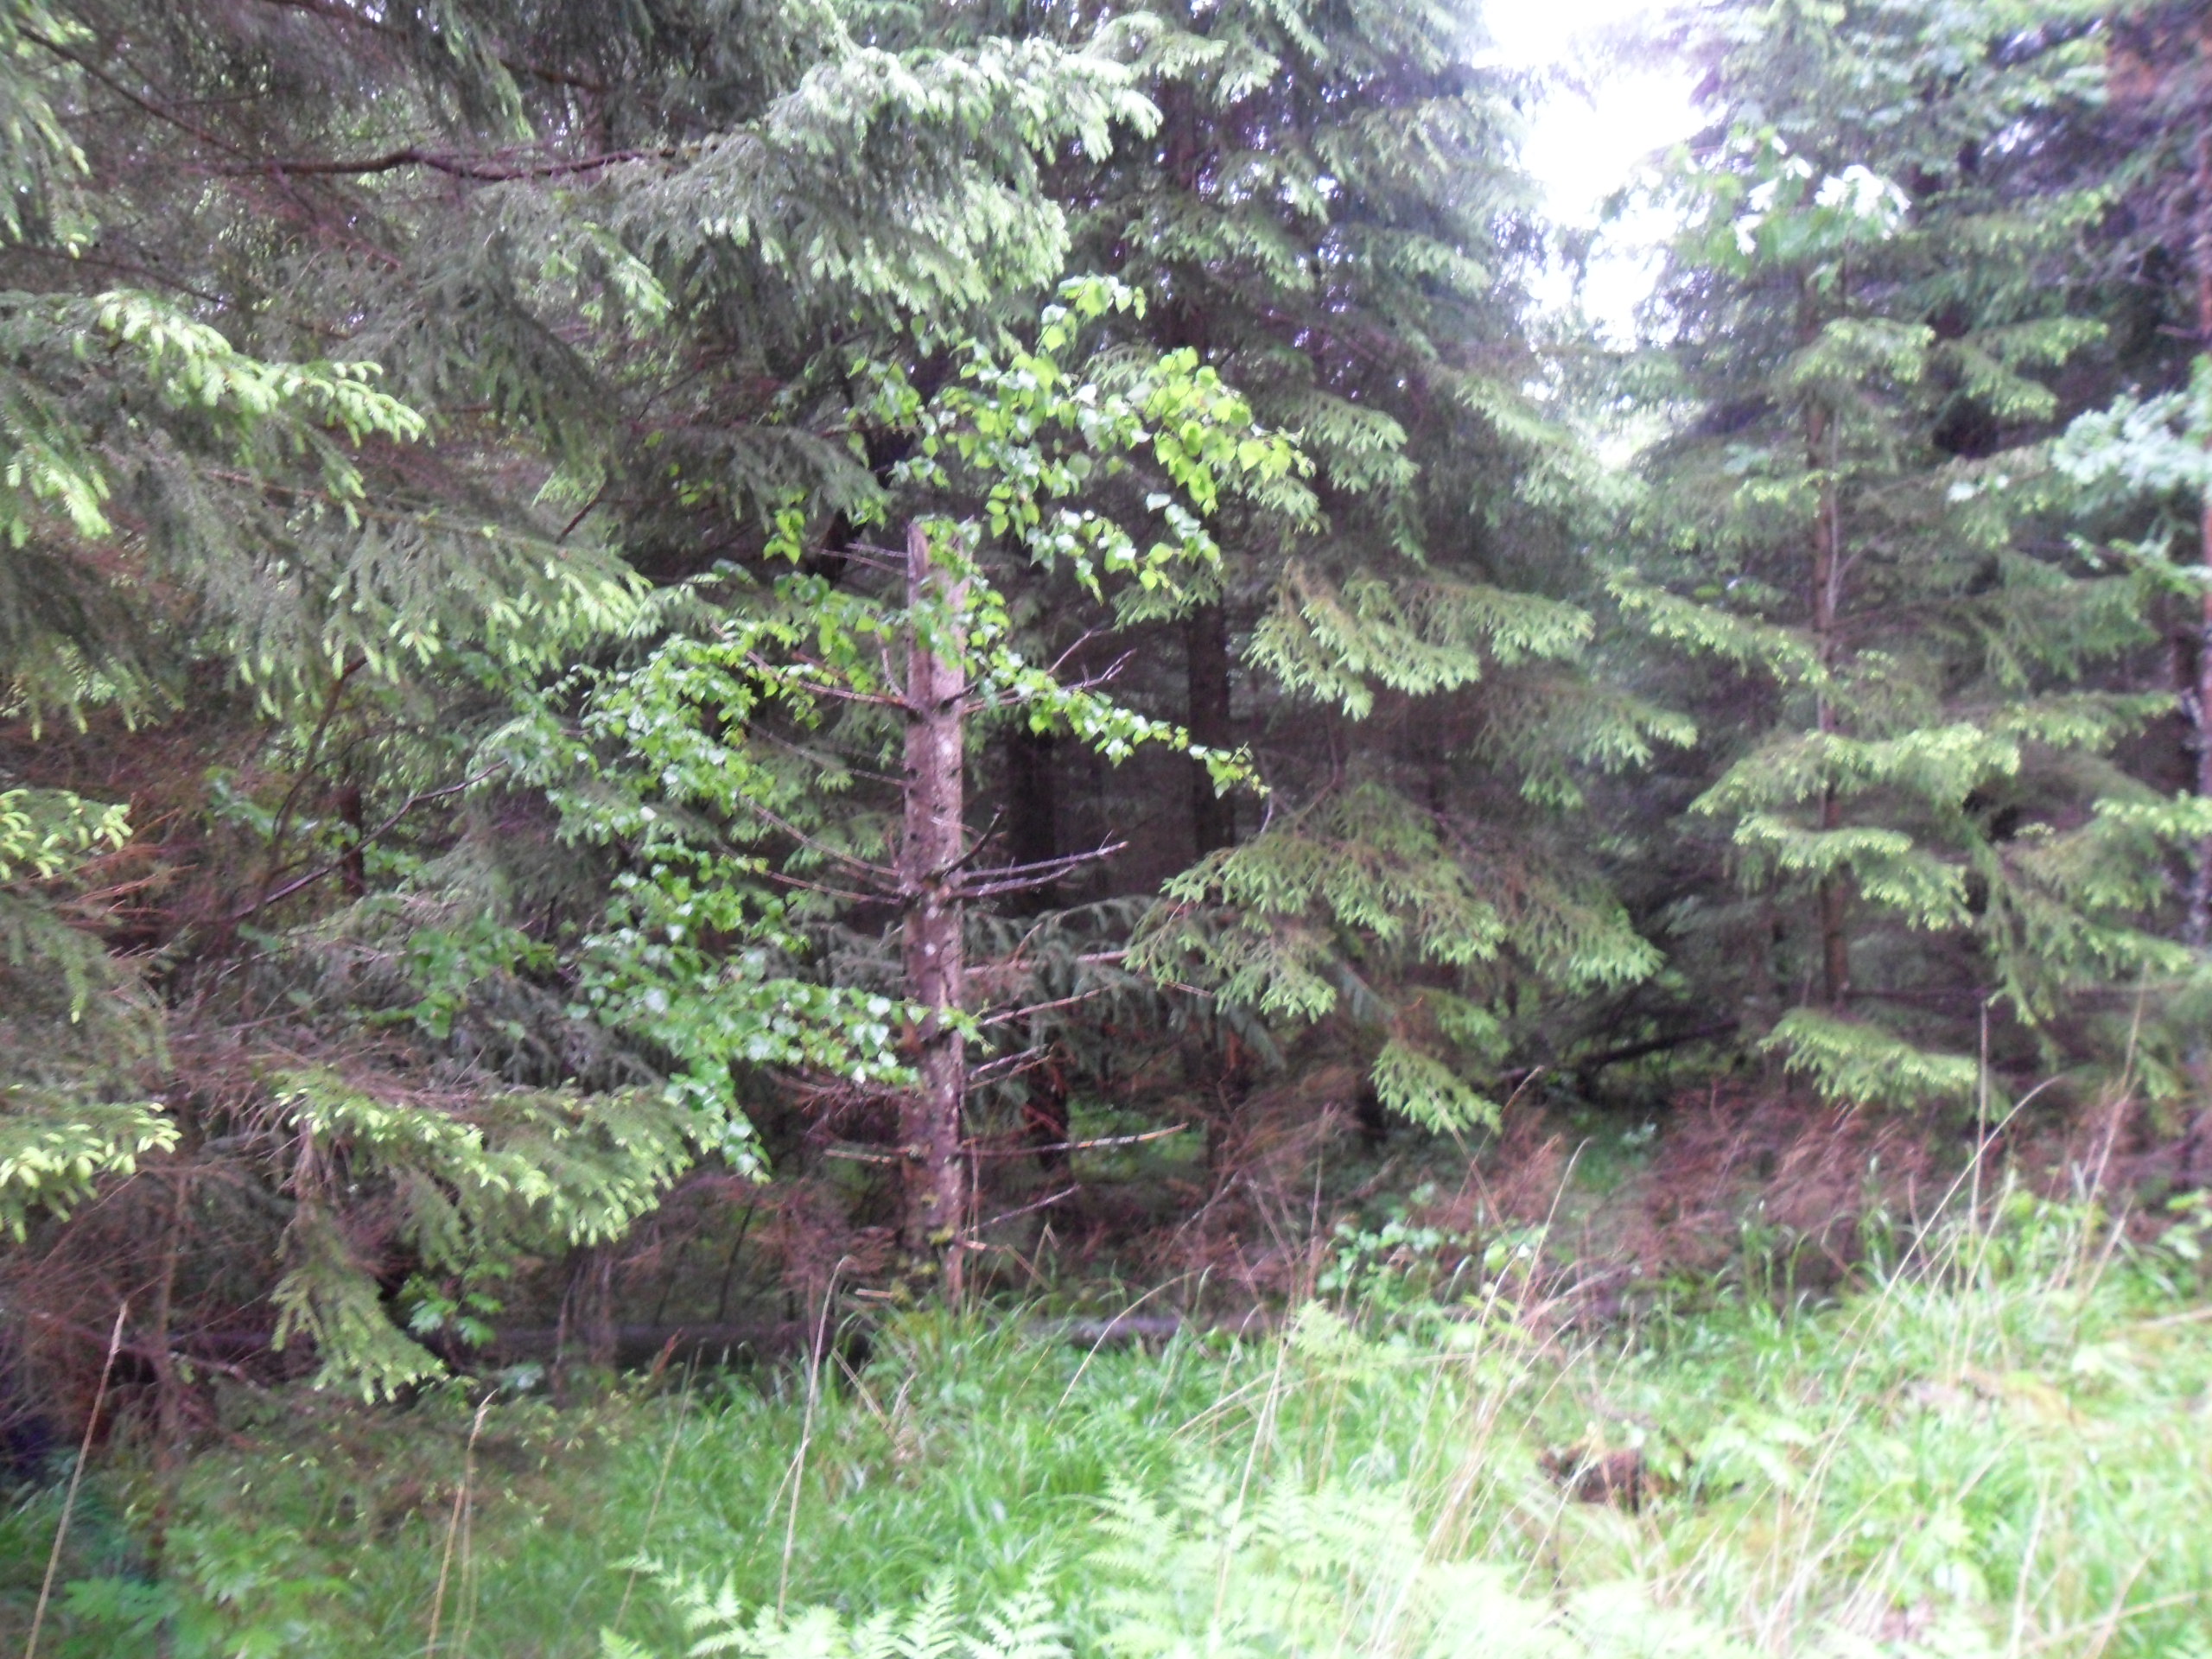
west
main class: Woodland
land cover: Spruce dominated coniferous woodland
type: hemiboreal forest and nemoral coniferous forest and mixed broadleaved-coniferous forest
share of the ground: > 75 %
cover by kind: coniferous forest trees 80 %, herbaceous plants 15 %, shrubs 5 %
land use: Forestry
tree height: > 5 m
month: June
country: LV
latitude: 57.3284
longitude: 22.0552
